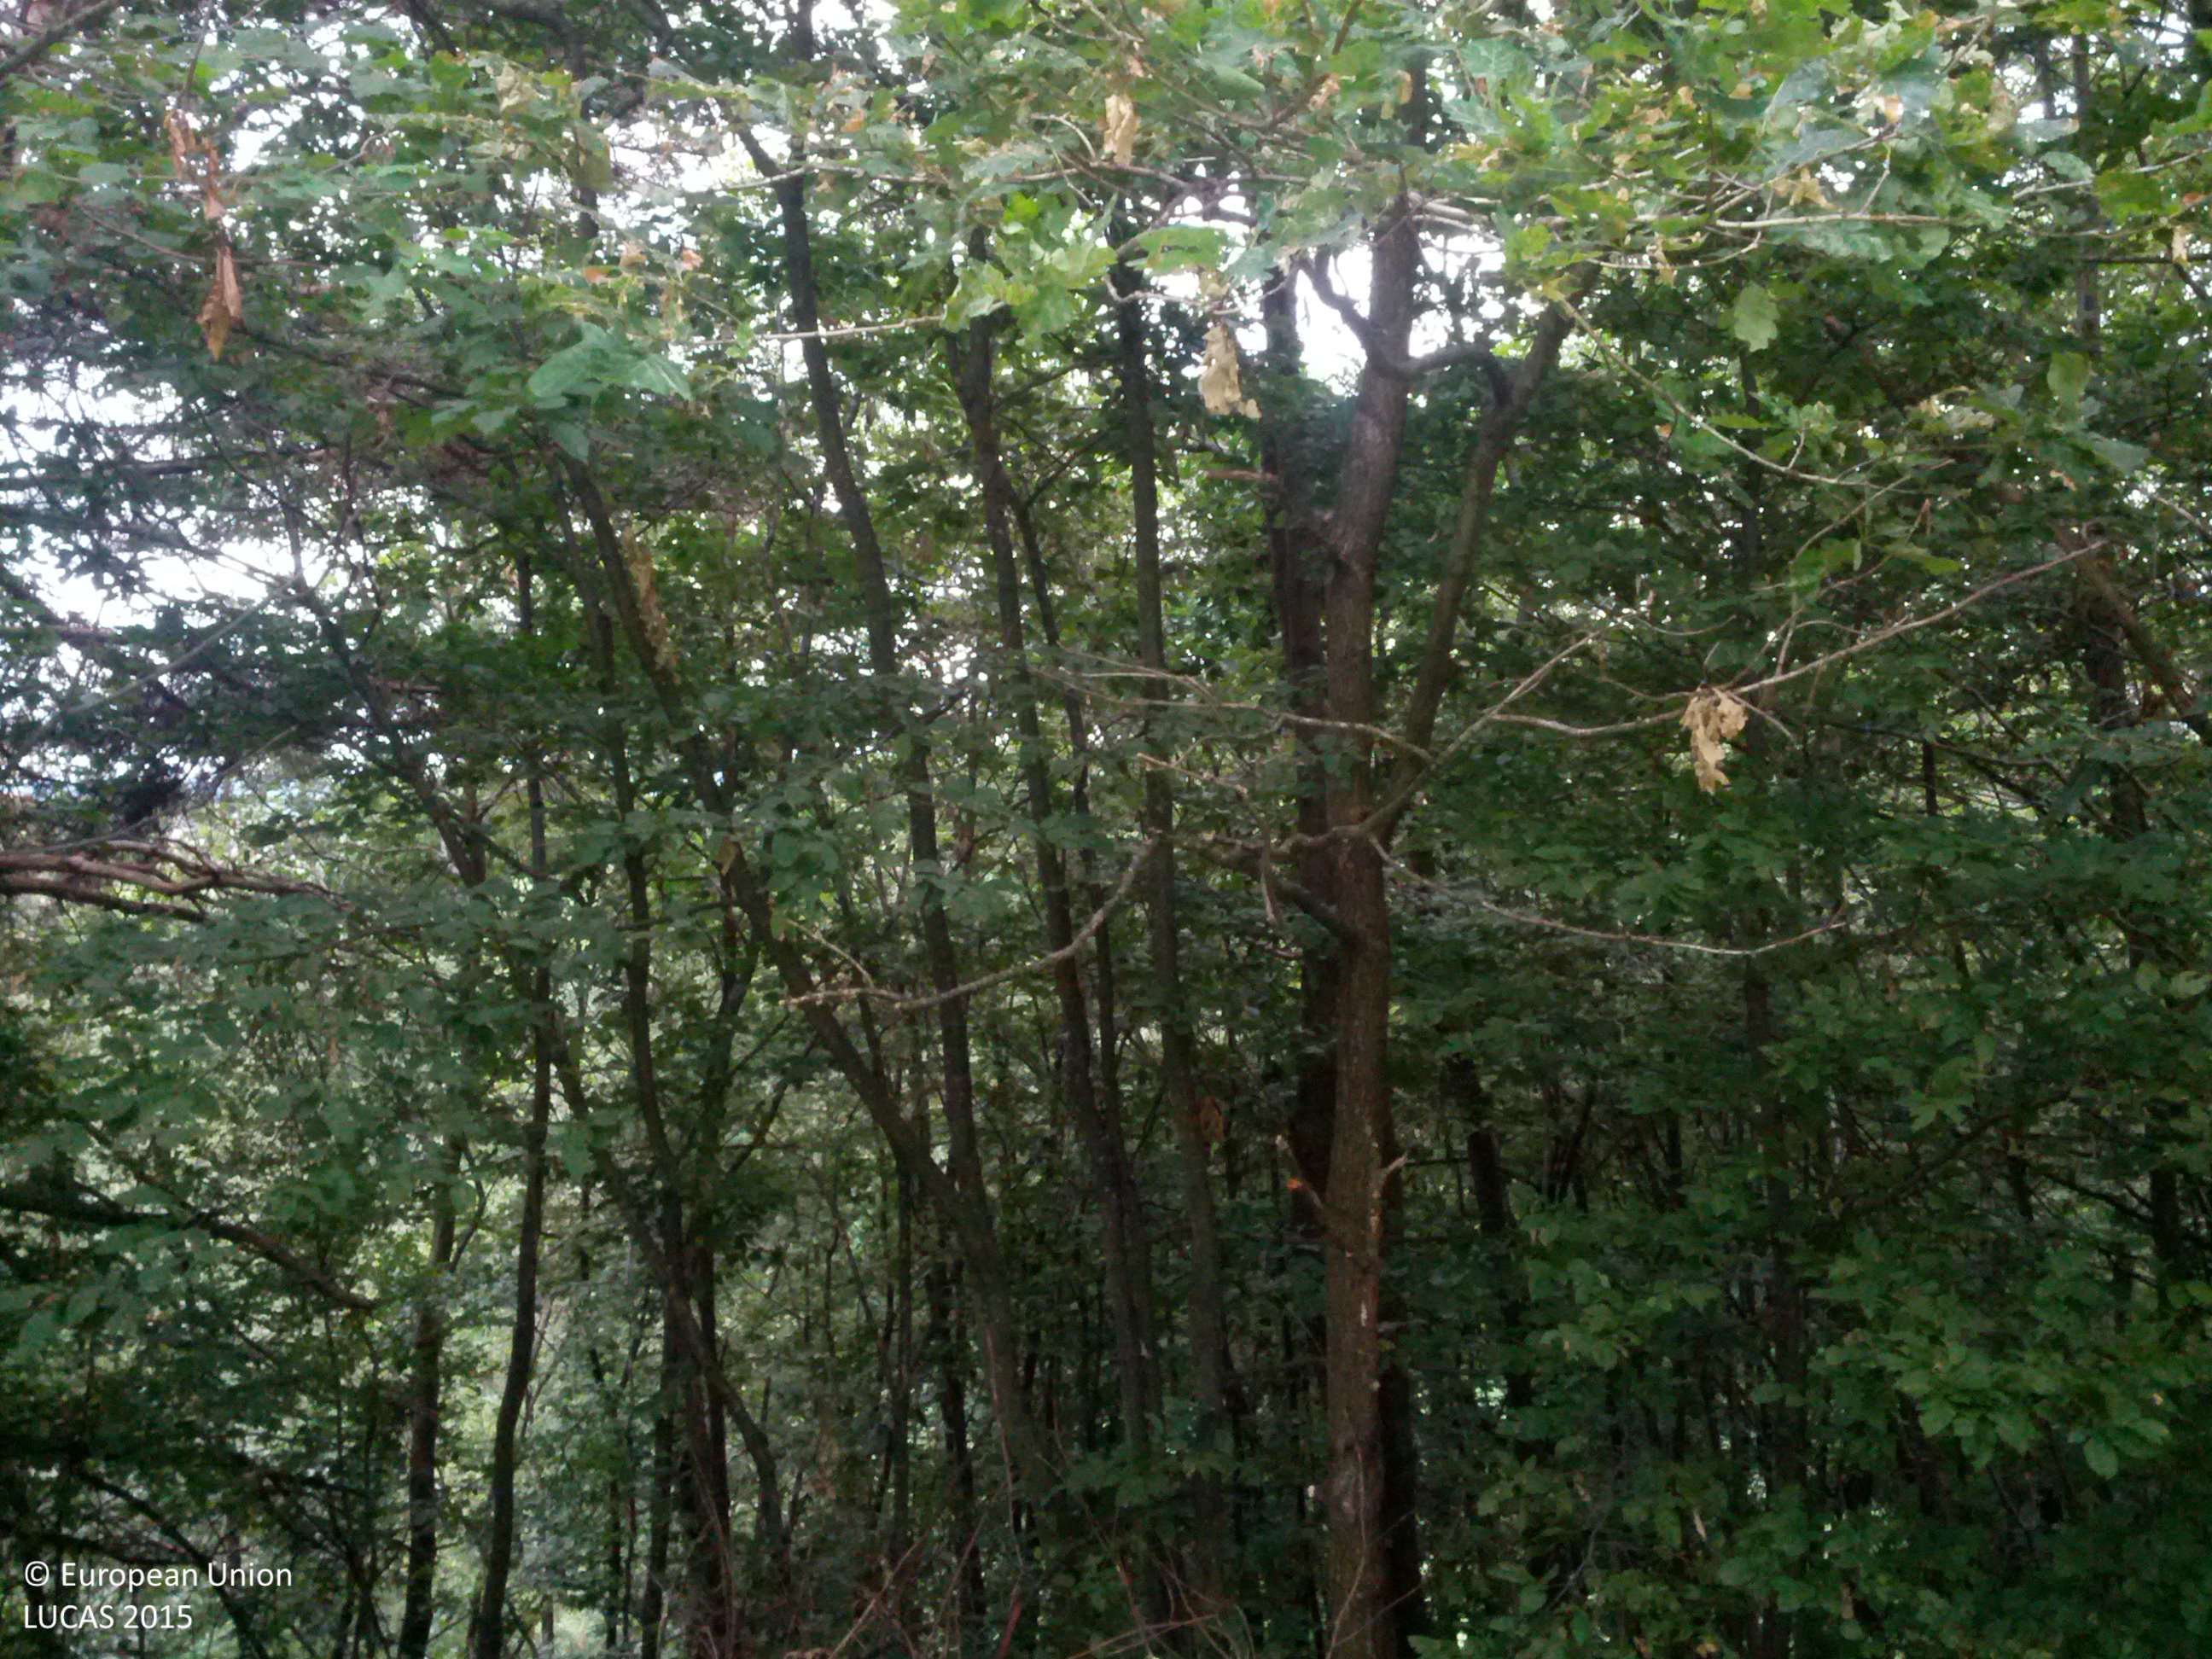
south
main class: Grassland
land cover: Grassland without tree/shrub cover
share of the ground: > 75 %
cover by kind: herbaceous plants 100 %
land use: Residential
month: July
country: AT
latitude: 47.4043
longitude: 16.1111
